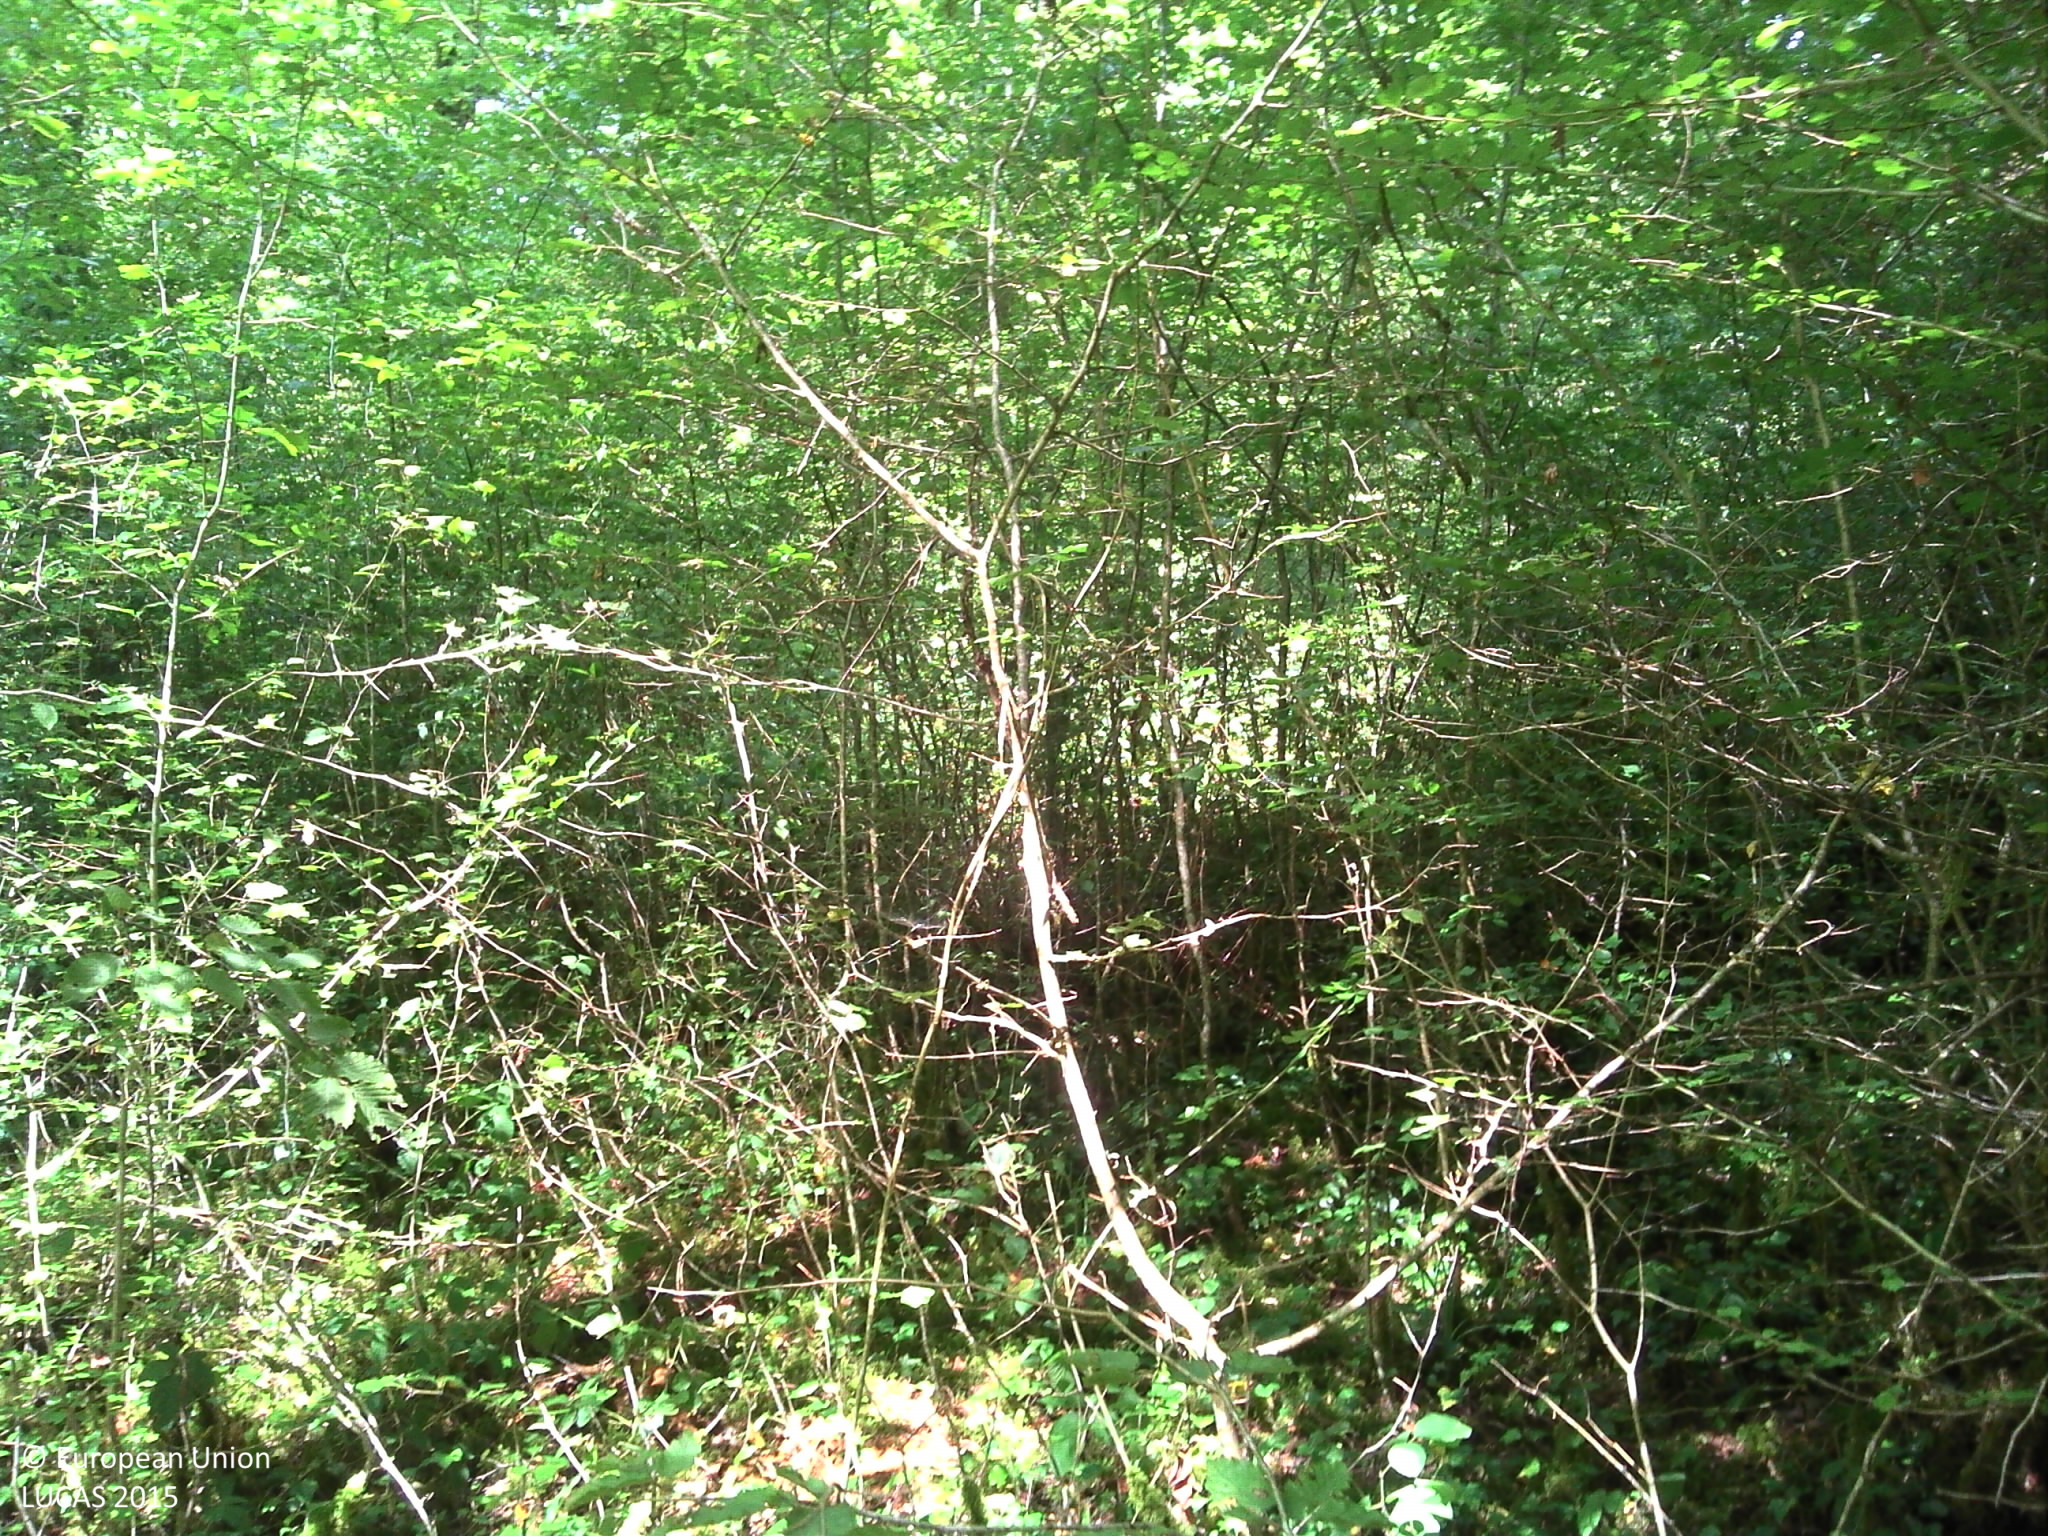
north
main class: Woodland
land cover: Broadleaved woodland
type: mesophytic deciduous forest
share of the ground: > 75 %
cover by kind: broadleaved forest trees 85 %, lichens and mosses 10 %, herbaceous plants 5 %
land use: Forestry
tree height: > 5 m
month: July
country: FR
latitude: 48.0725
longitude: 4.9660
